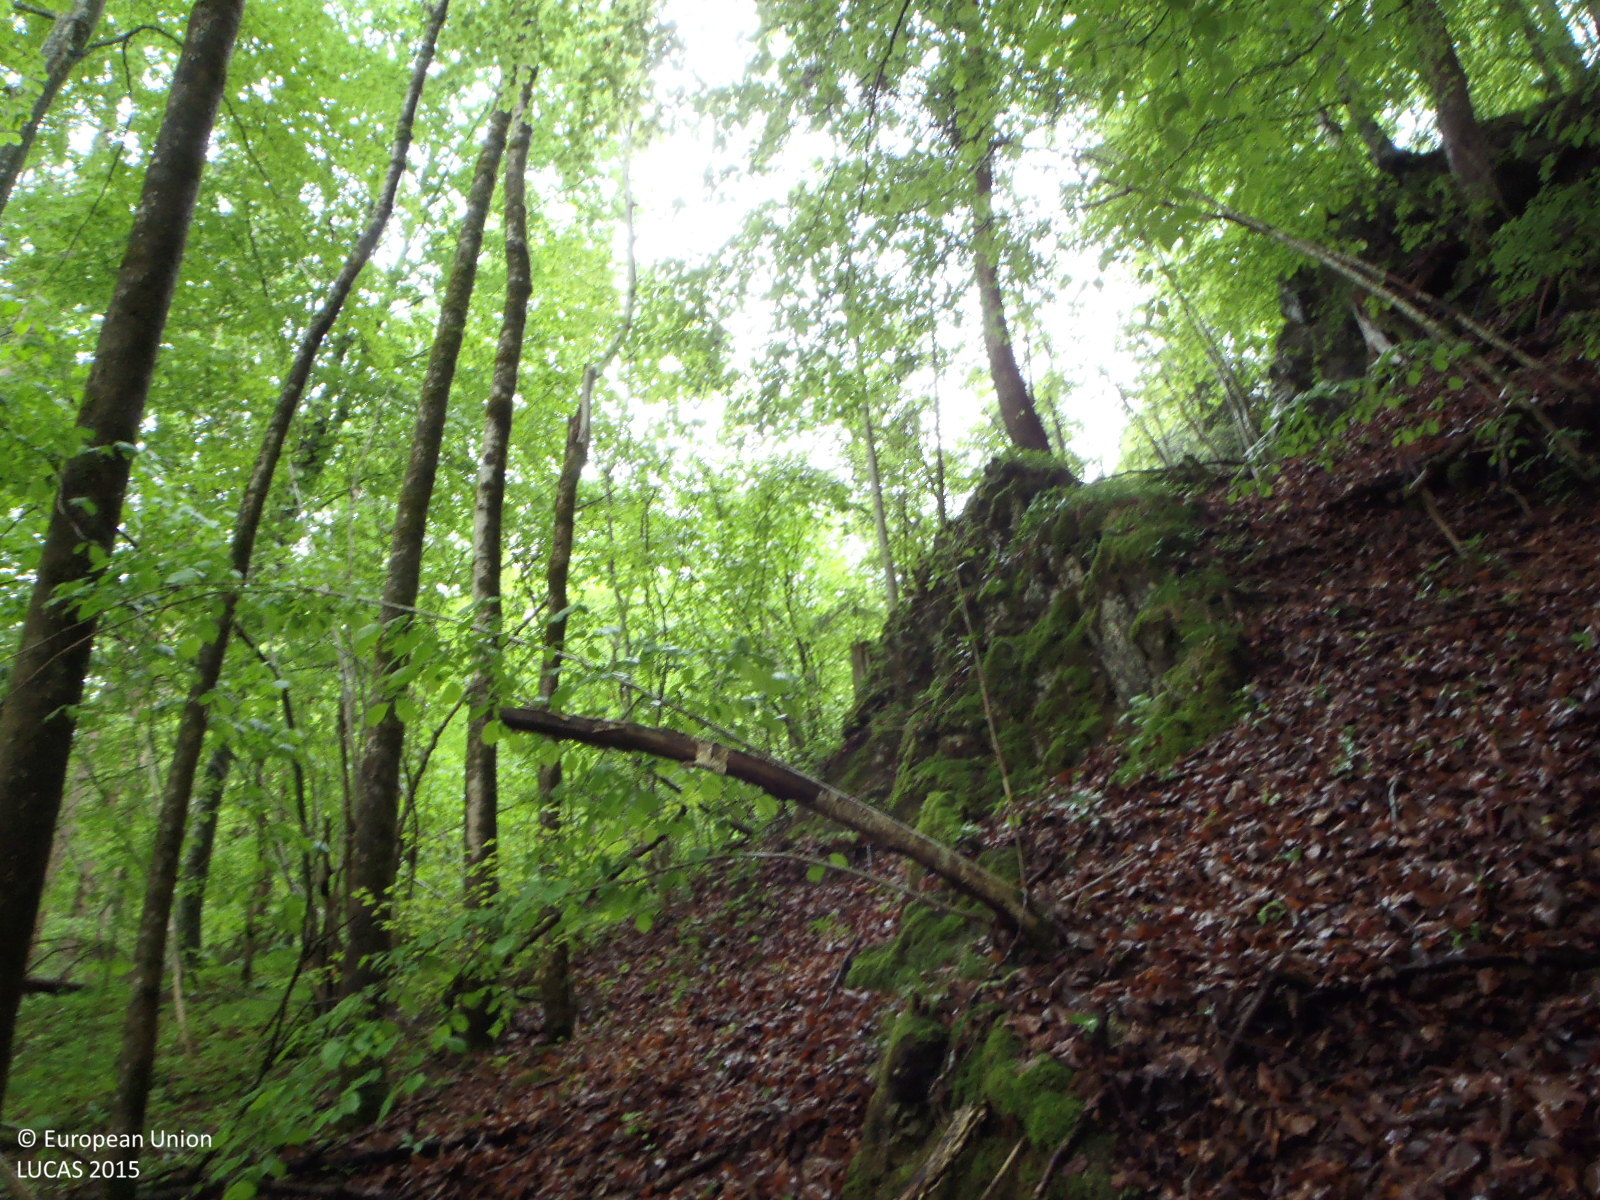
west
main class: Woodland
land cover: Broadleaved woodland
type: mountainous beech forest
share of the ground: > 75 %
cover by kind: broadleaved forest trees 75 %, shrubs 10 %, coniferous forest trees 5 %, herbaceous plants 5 %, unconsolidated bare surface 5 %
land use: Forestry
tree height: > 5 m
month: May
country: AT
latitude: 47.6143
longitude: 12.6991
